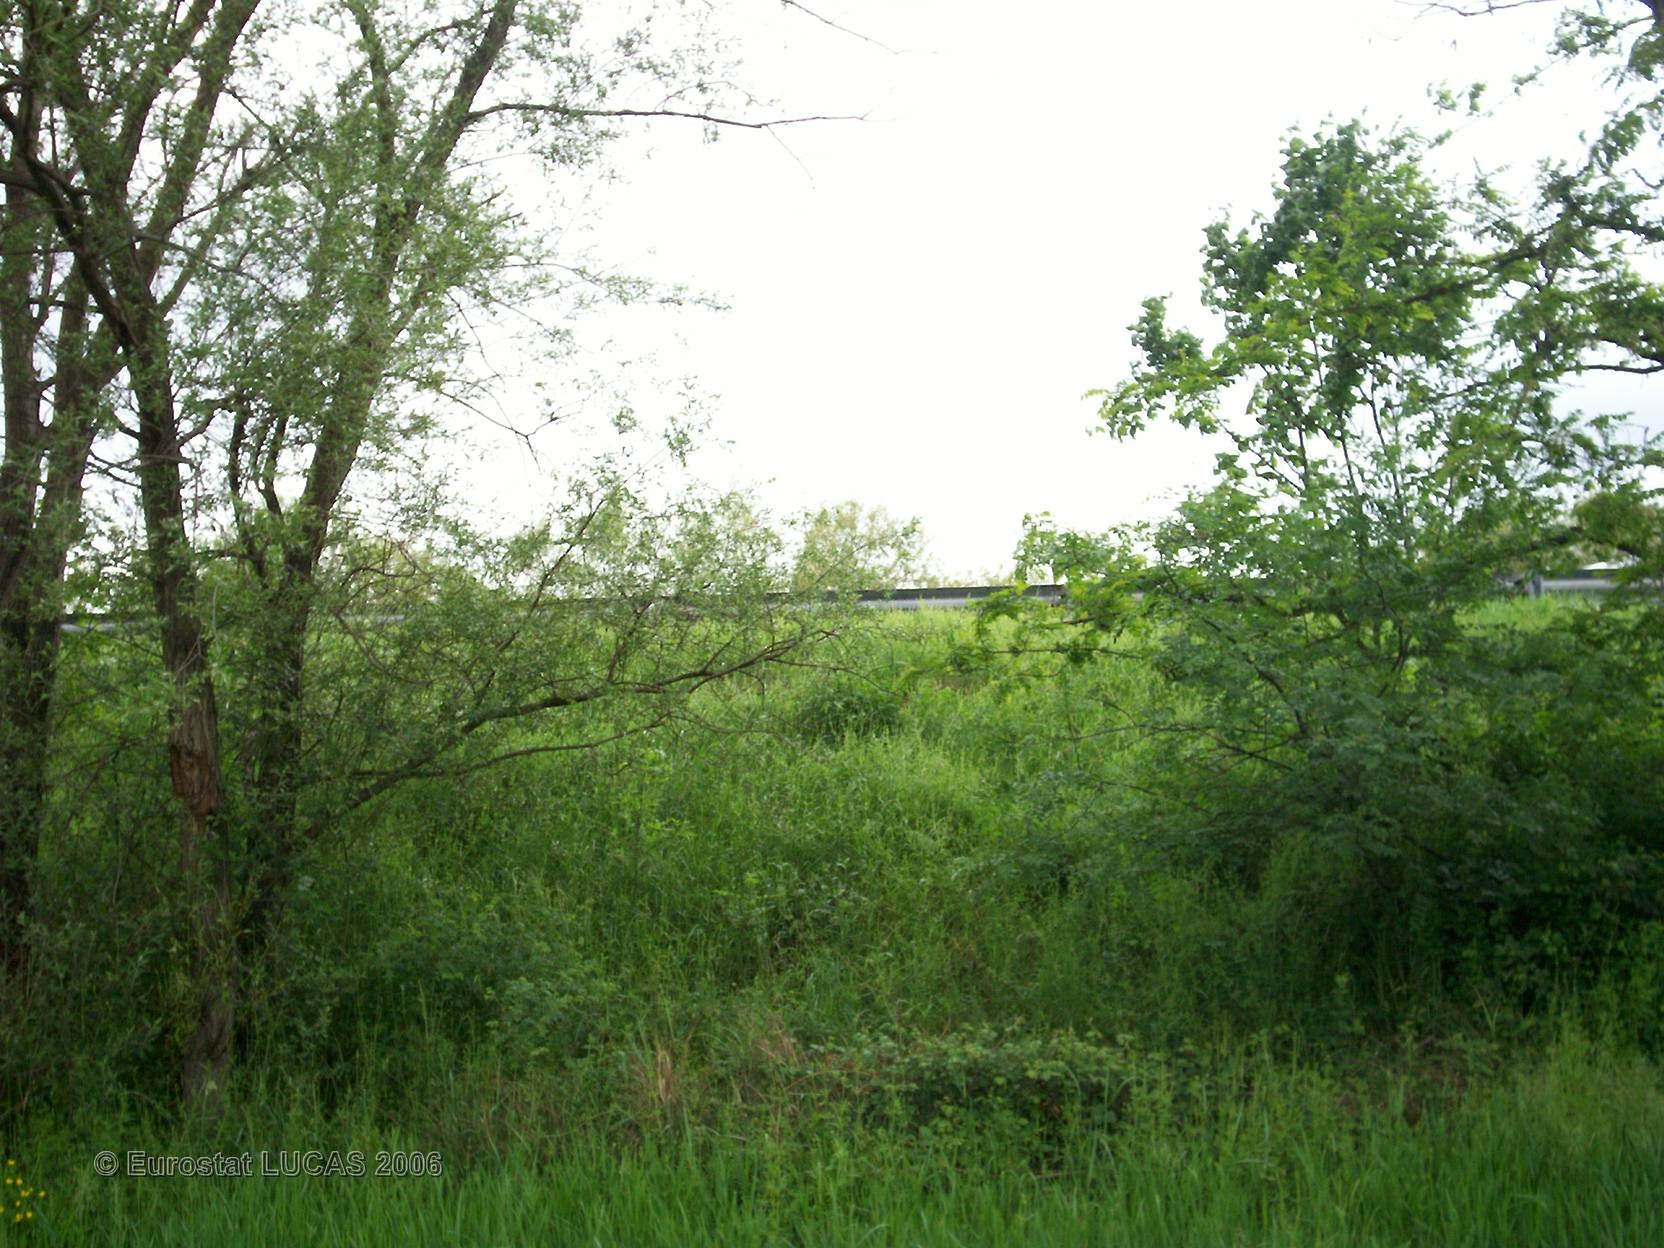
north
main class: Grassland
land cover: Grassland without tree/shrub cover
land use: Agriculture (excluding fallow land and kitchen gardens)
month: May
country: FR
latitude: 45.9170
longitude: 4.7814
